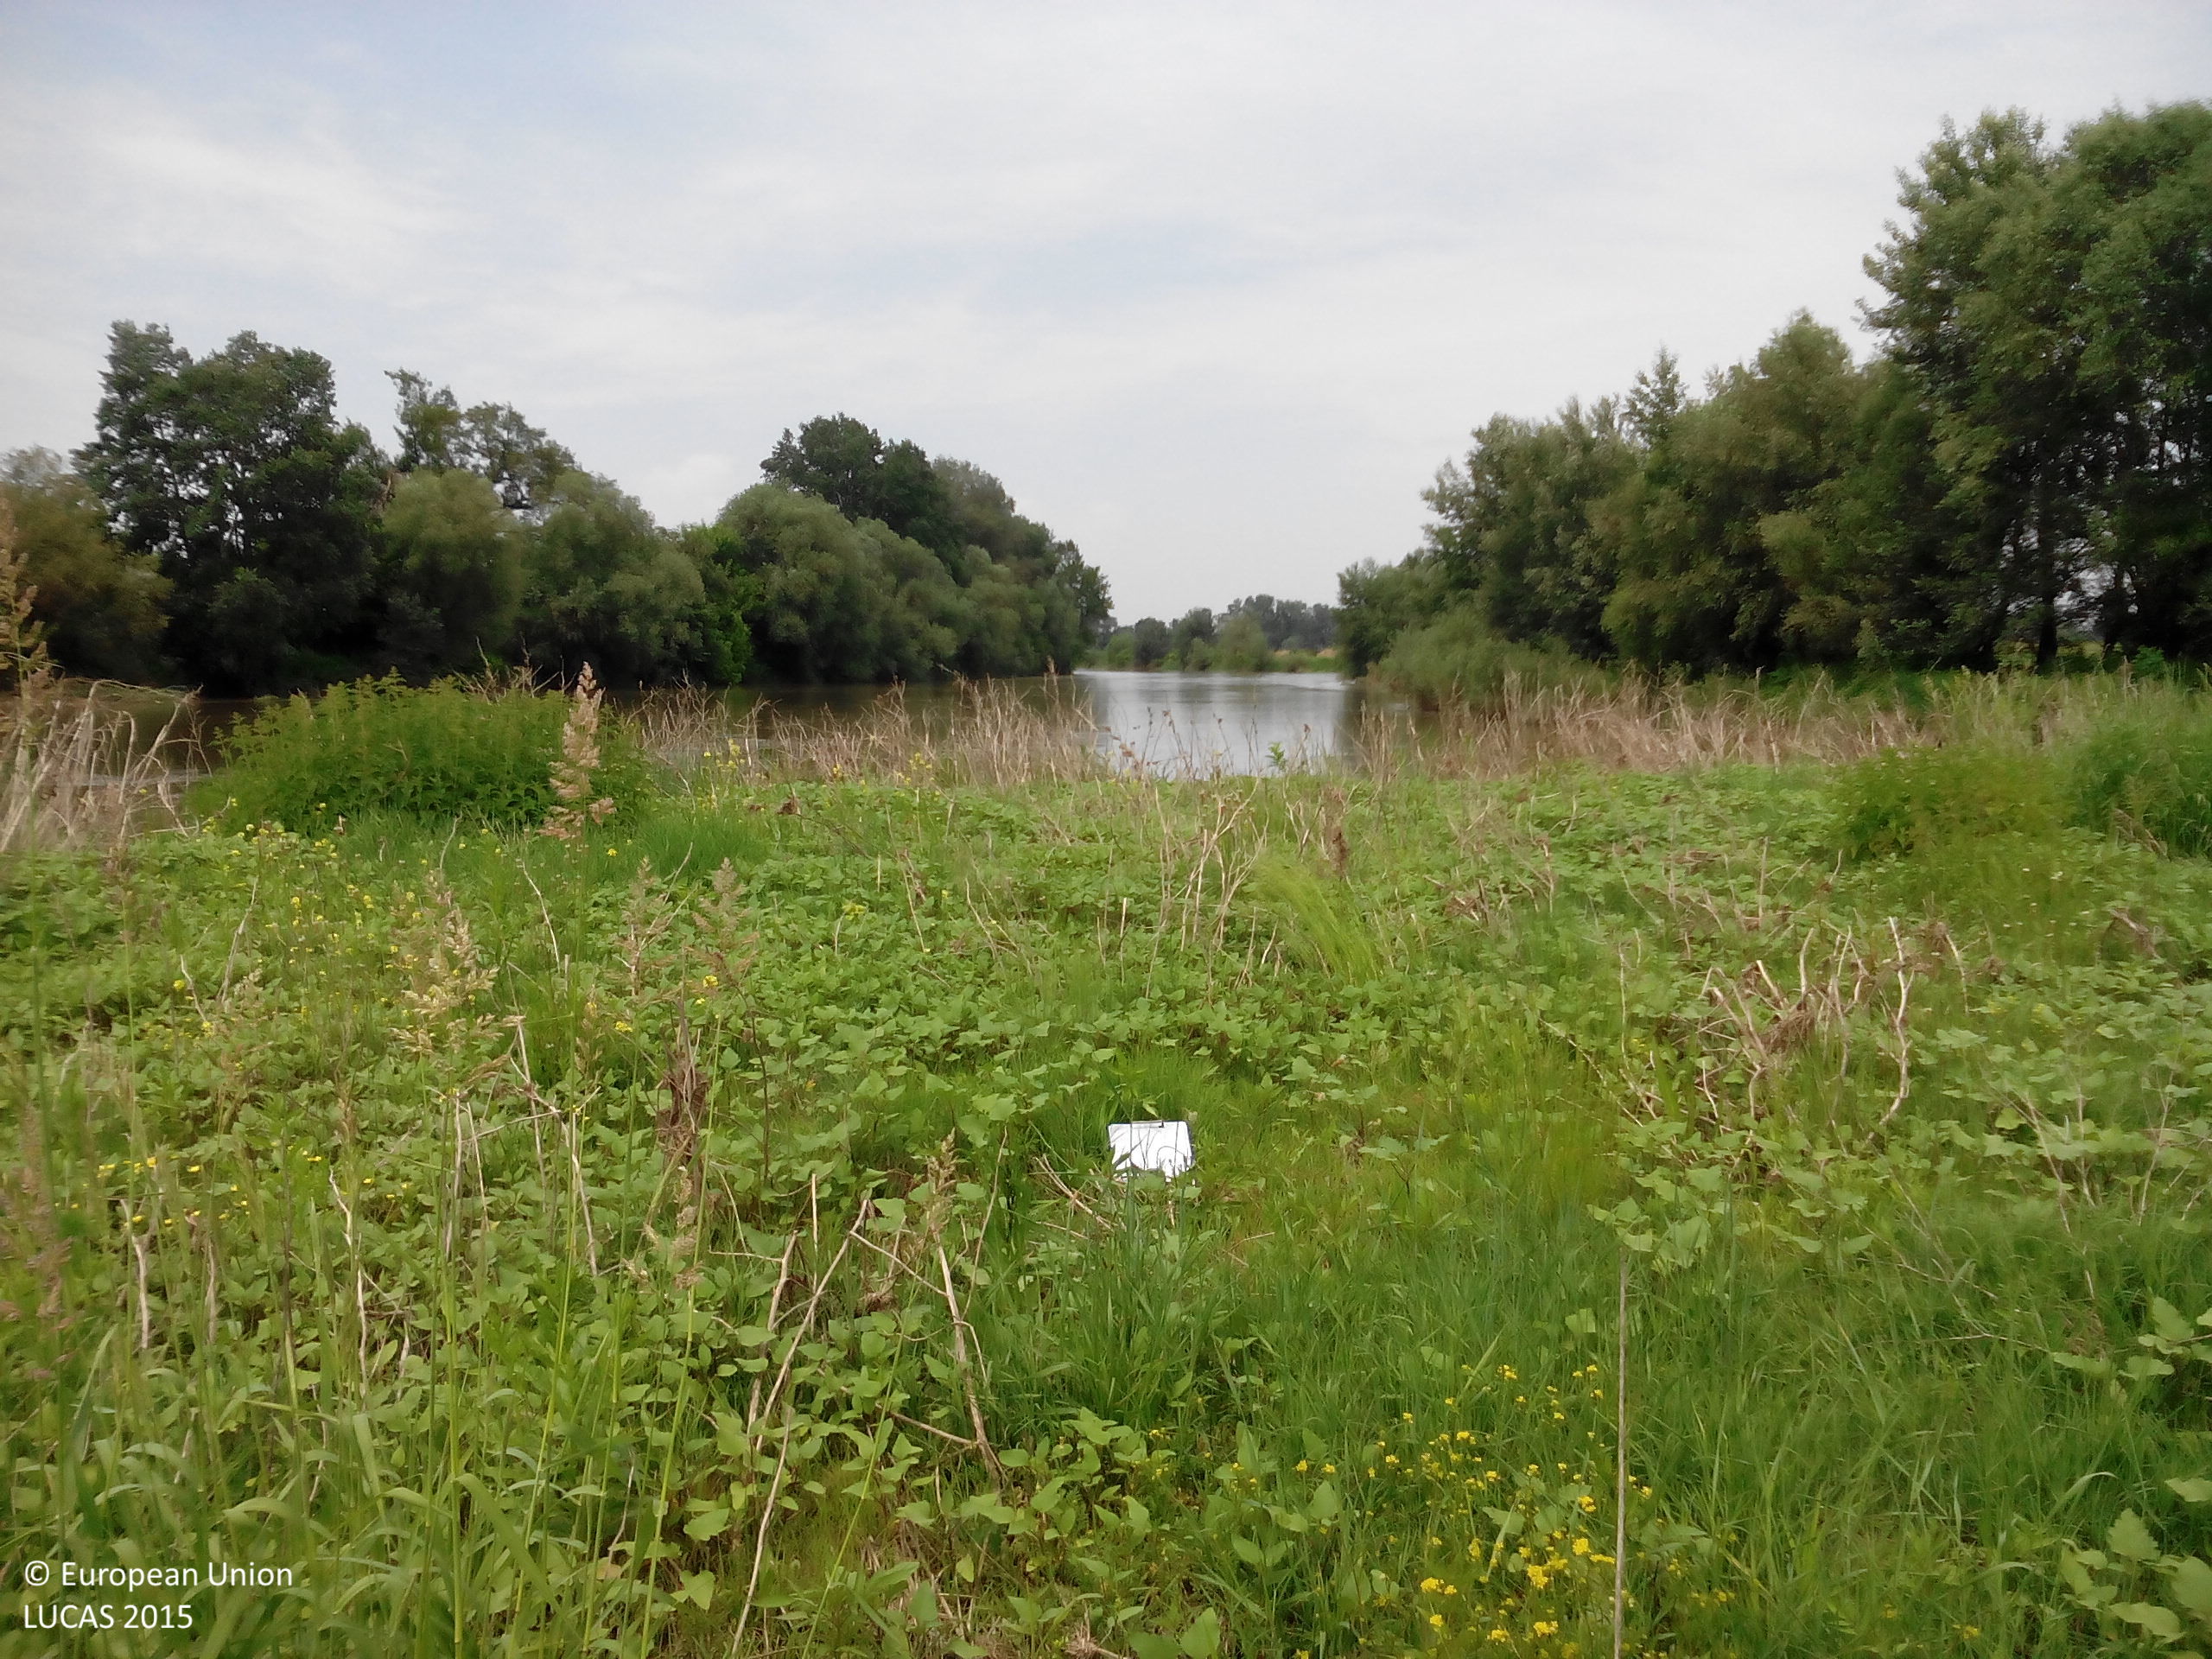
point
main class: Grassland
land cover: Grassland without tree/shrub cover
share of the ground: > 75 %
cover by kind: herbaceous plants 95 %, shrubs 5 %
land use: Agriculture (excluding fallow land and kitchen gardens)
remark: Temporary dry
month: May
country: BG
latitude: 43.4907
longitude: 24.2402
